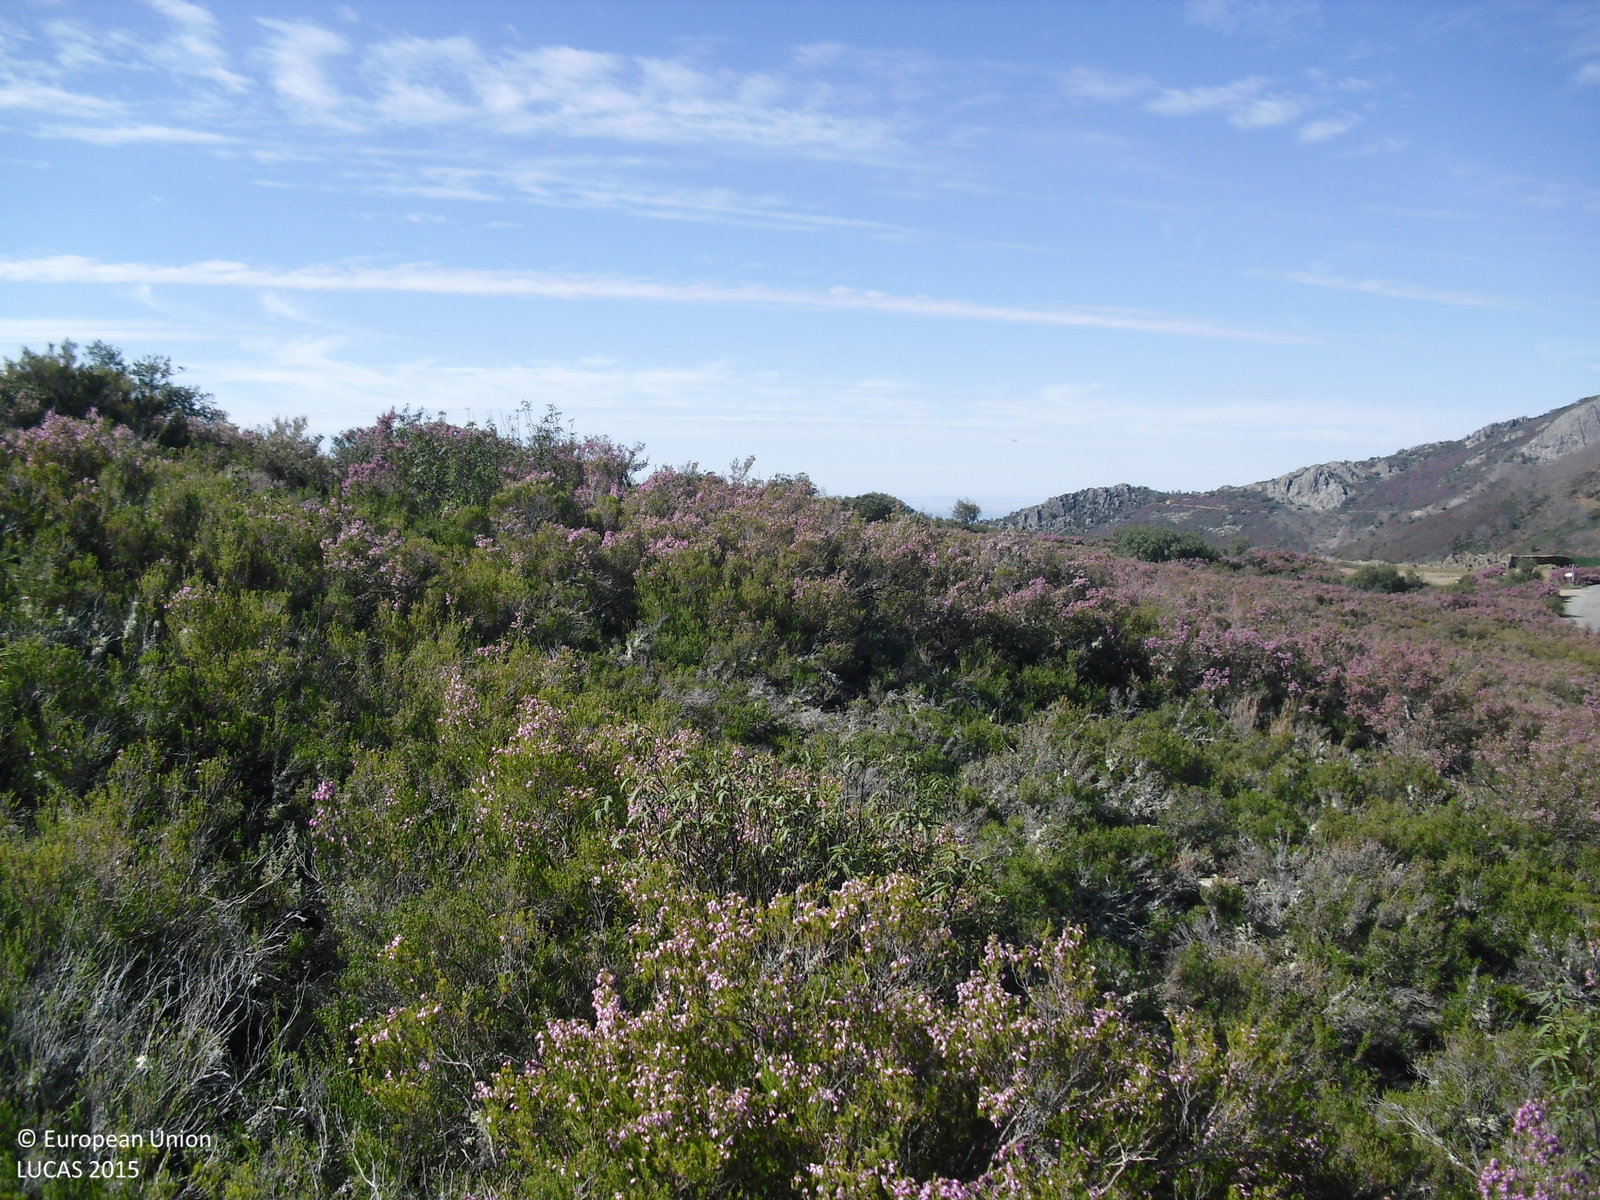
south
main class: Shrubland
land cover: Shrubland without tree cover
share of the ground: > 75 %
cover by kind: shrubs 100 %
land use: Semi-natural and natural areas not in use
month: April
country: ES
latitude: 39.4691
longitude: -5.3812
